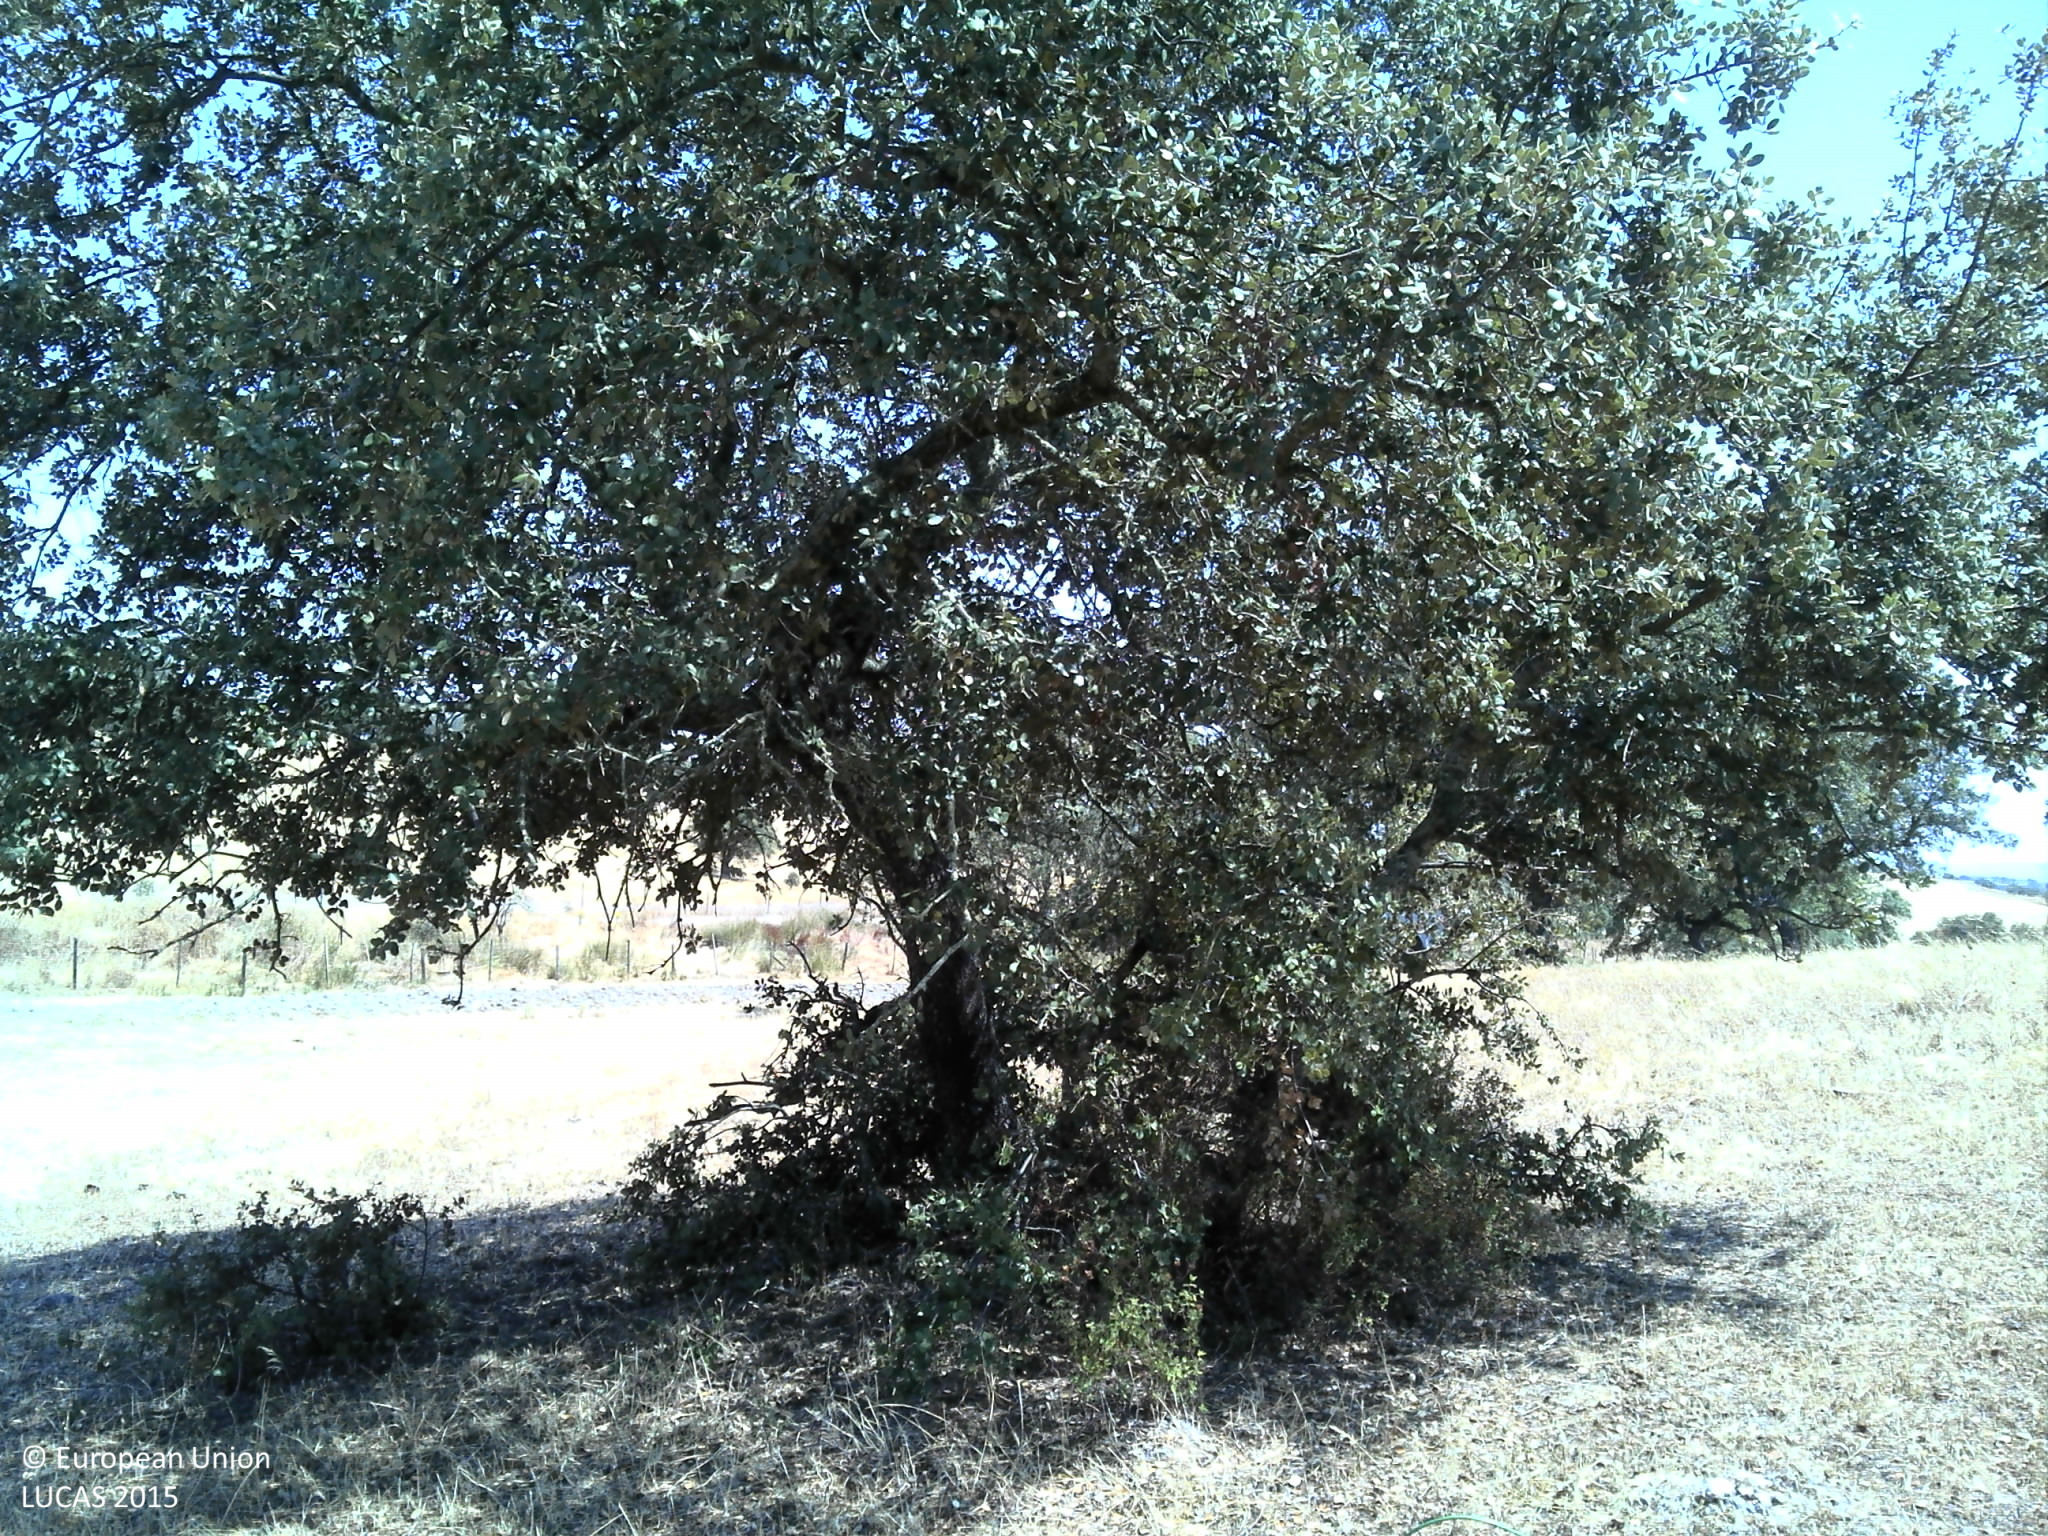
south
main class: Woodland
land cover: Broadleaved woodland
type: broadleaved evergreen forest
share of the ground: 10 - 25 %
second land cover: Grassland without tree/shrub cover
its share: 10 - 25 %
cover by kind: unconsolidated bare surface 55 %, broadleaved forest trees 25 %, herbaceous plants 20 %
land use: Forestry
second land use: Agriculture (excluding fallow land and kitchen gardens)
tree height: > 5 m
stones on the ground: < 10 %
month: June
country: PT
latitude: 38.2187
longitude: -7.3004
